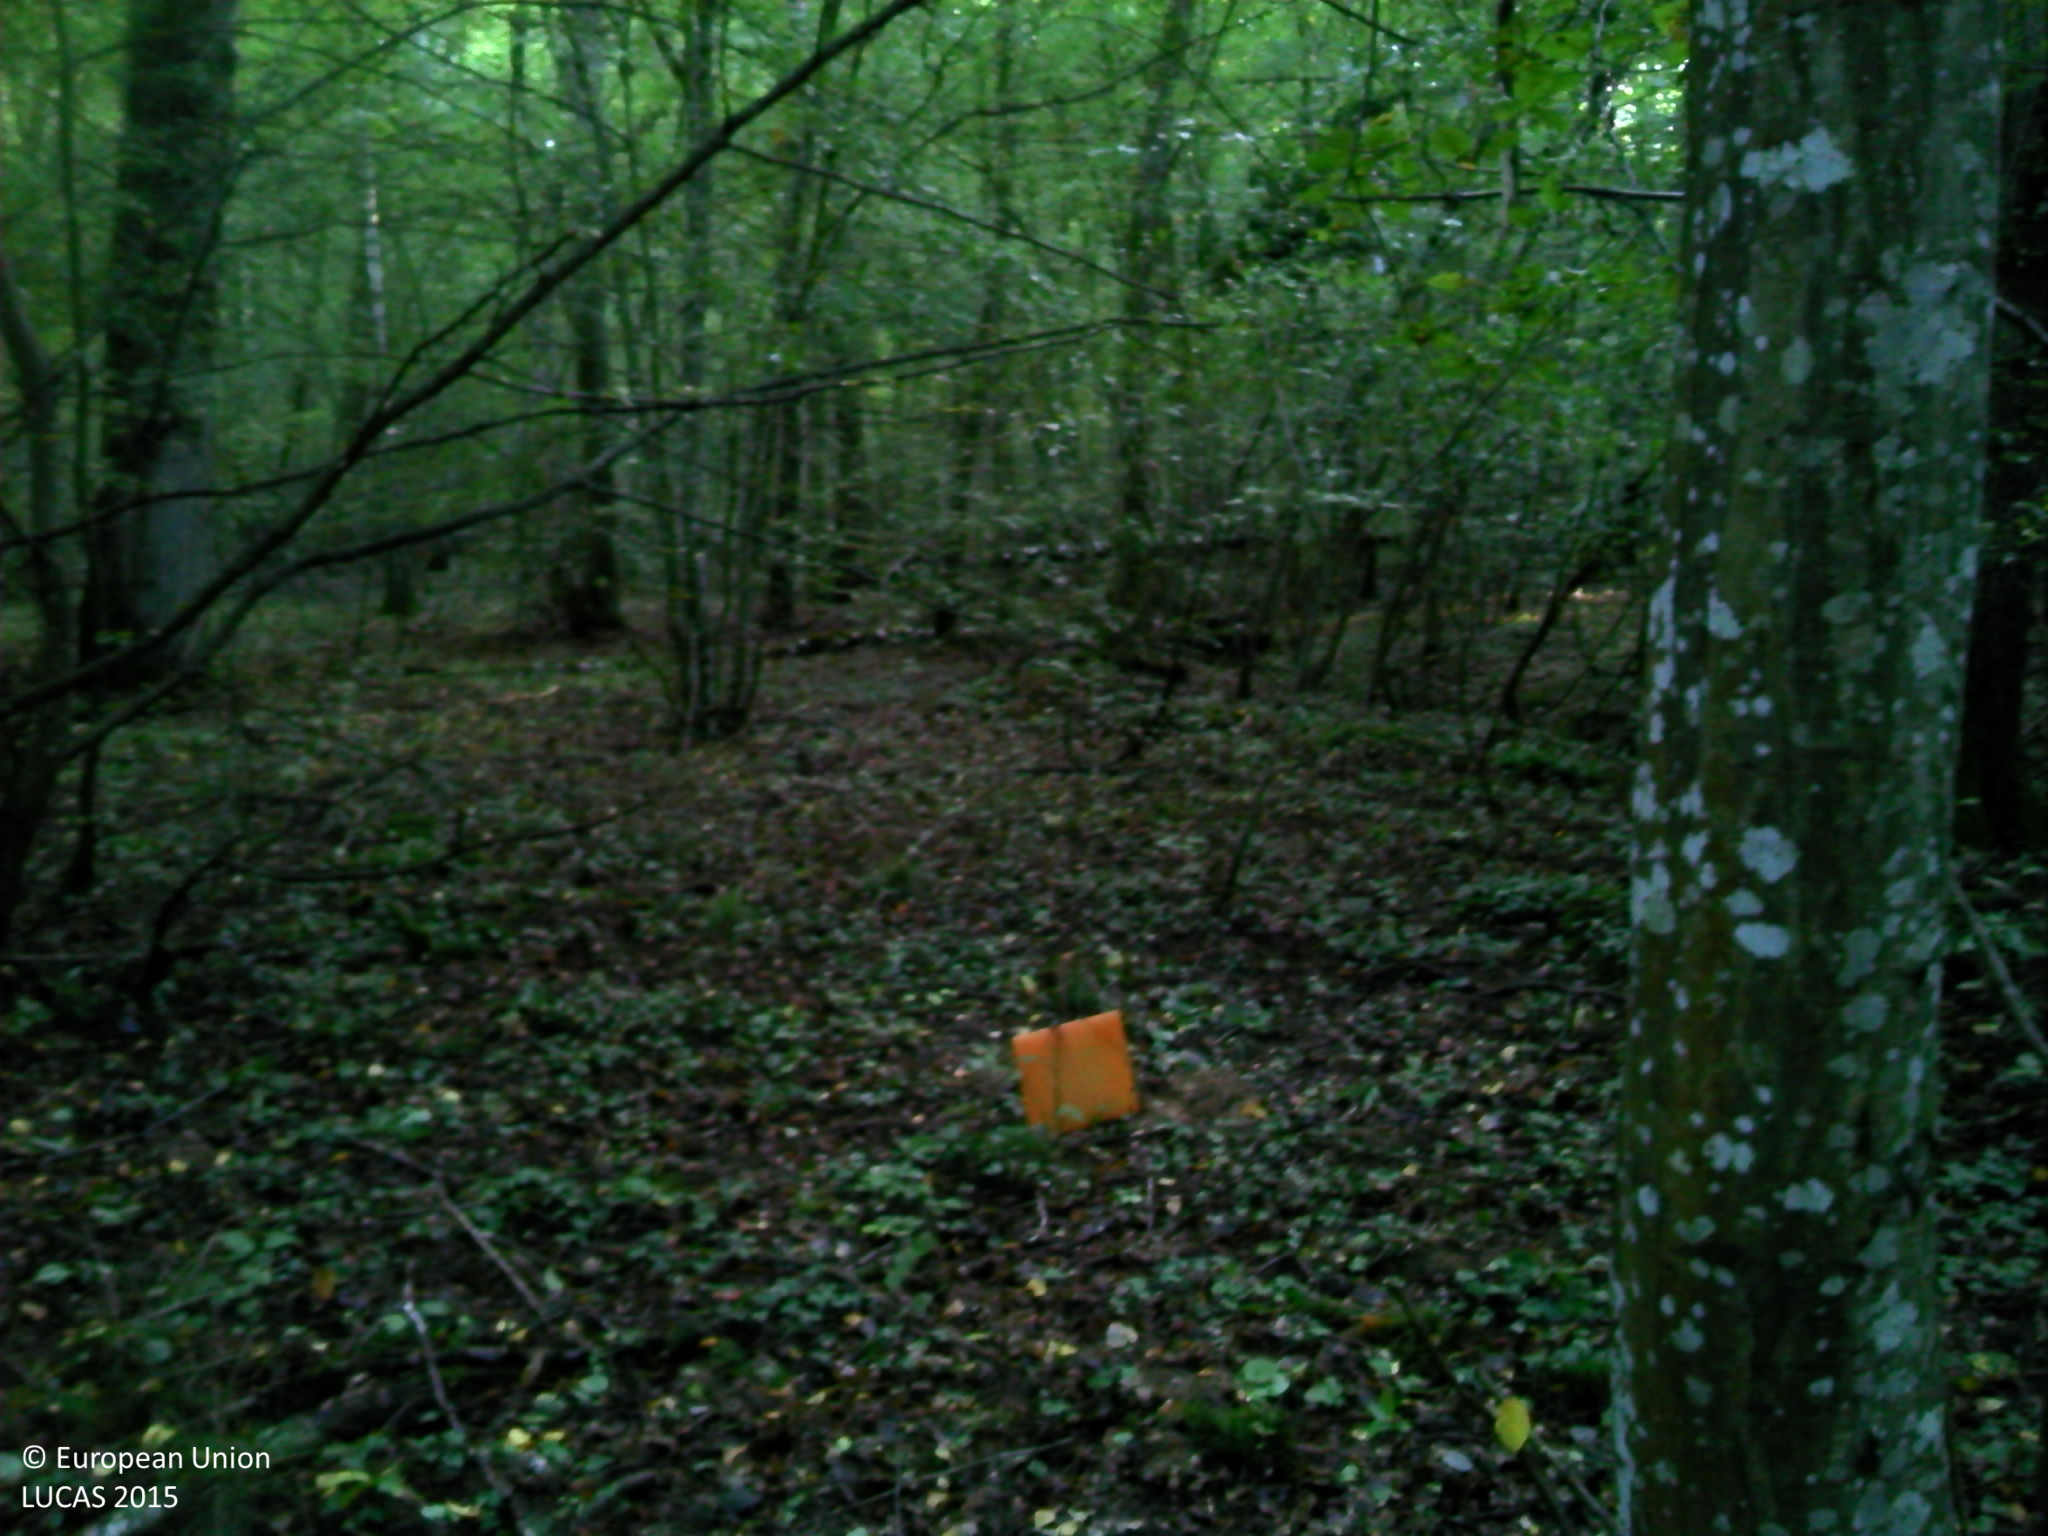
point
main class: Woodland
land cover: Broadleaved woodland
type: mesophytic deciduous forest
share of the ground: > 75 %
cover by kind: broadleaved forest trees 95 %, herbaceous plants 5 %
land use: Forestry
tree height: > 5 m
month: September
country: FR
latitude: 47.0611
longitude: 4.9319
